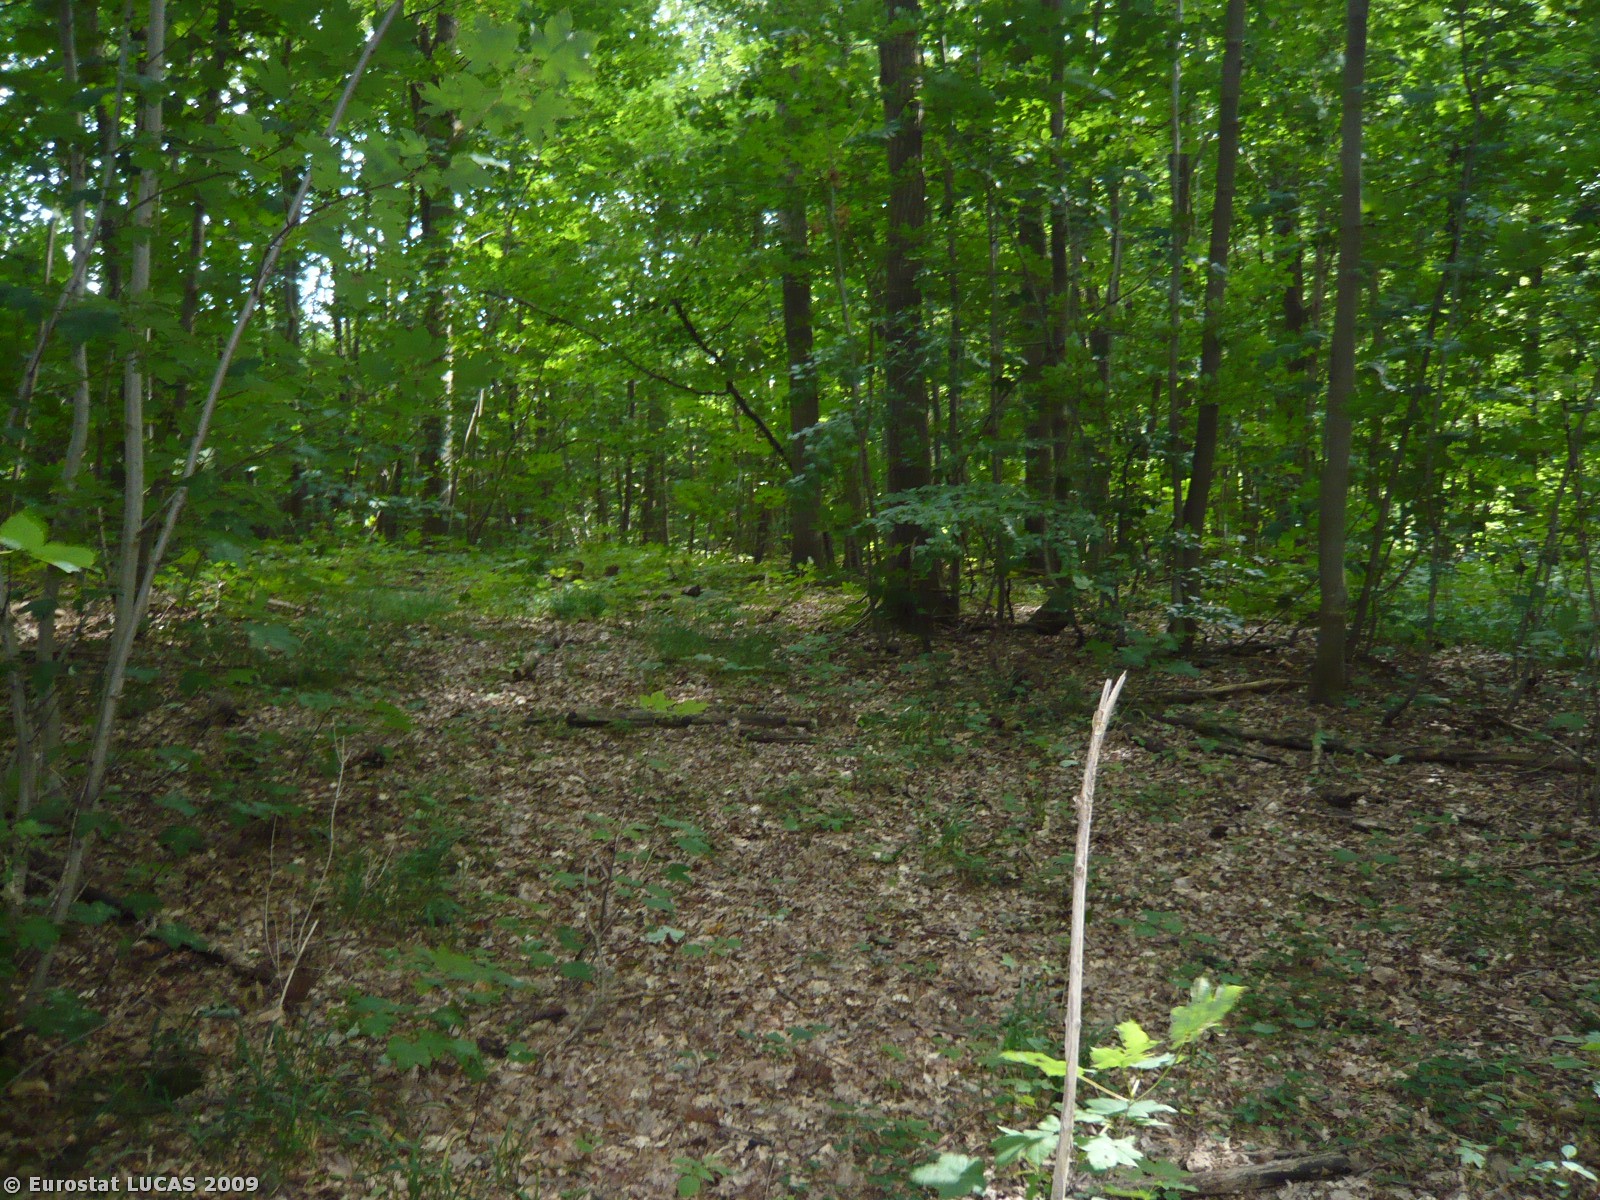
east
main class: Woodland
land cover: Broadleaved woodland
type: mesophytic deciduous forest
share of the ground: > 75 %
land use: Amenities, museums, leisure
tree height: > 5 m
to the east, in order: Broadleaved woodland; Tracks; Broadleaved woodland; Tracks; Spontaneously vegetated surfaces; Tracks; Spontaneously vegetated surfaces
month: July
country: DK
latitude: 55.8426
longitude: 12.3455
